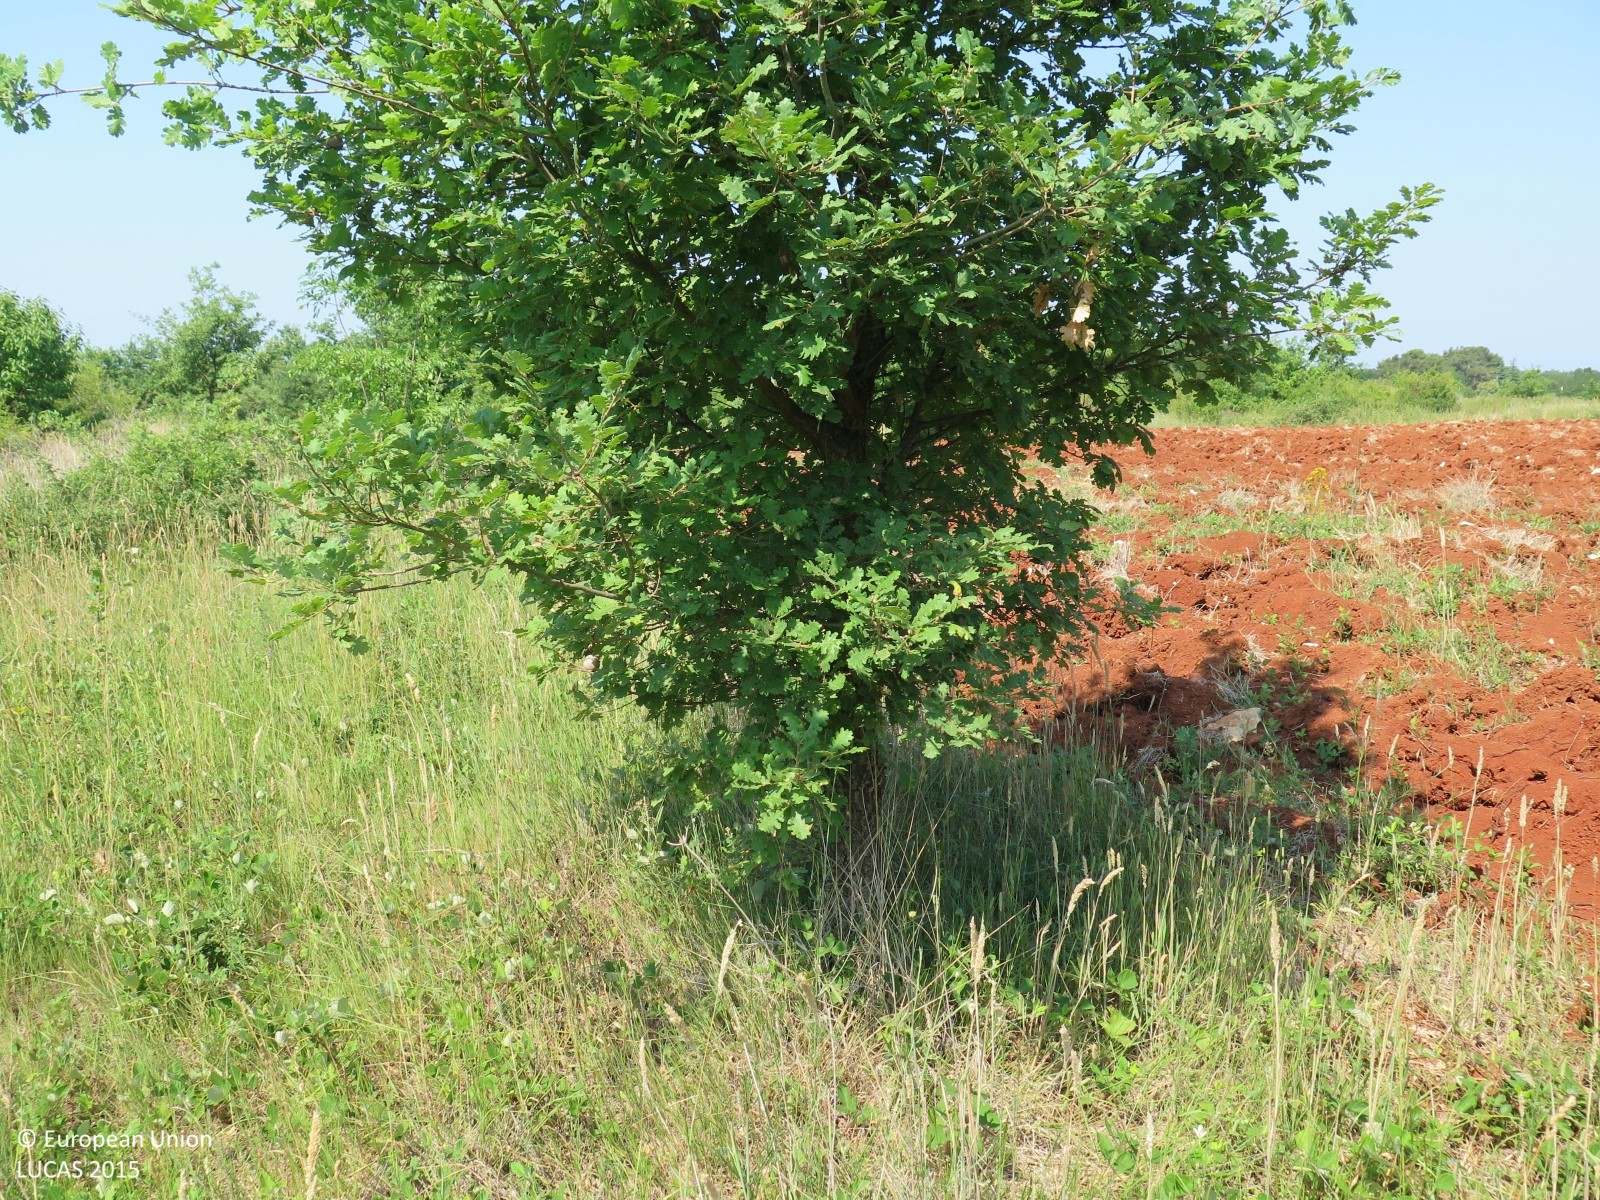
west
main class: Grassland
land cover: Grassland with sparse tree/shrub cover
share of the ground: > 75 %
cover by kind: herbaceous plants 90 %, broadleaved forest trees 5 %, shrubs 5 %
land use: Semi-natural and natural areas not in use
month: July
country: HR
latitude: 45.2788
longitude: 13.6536
